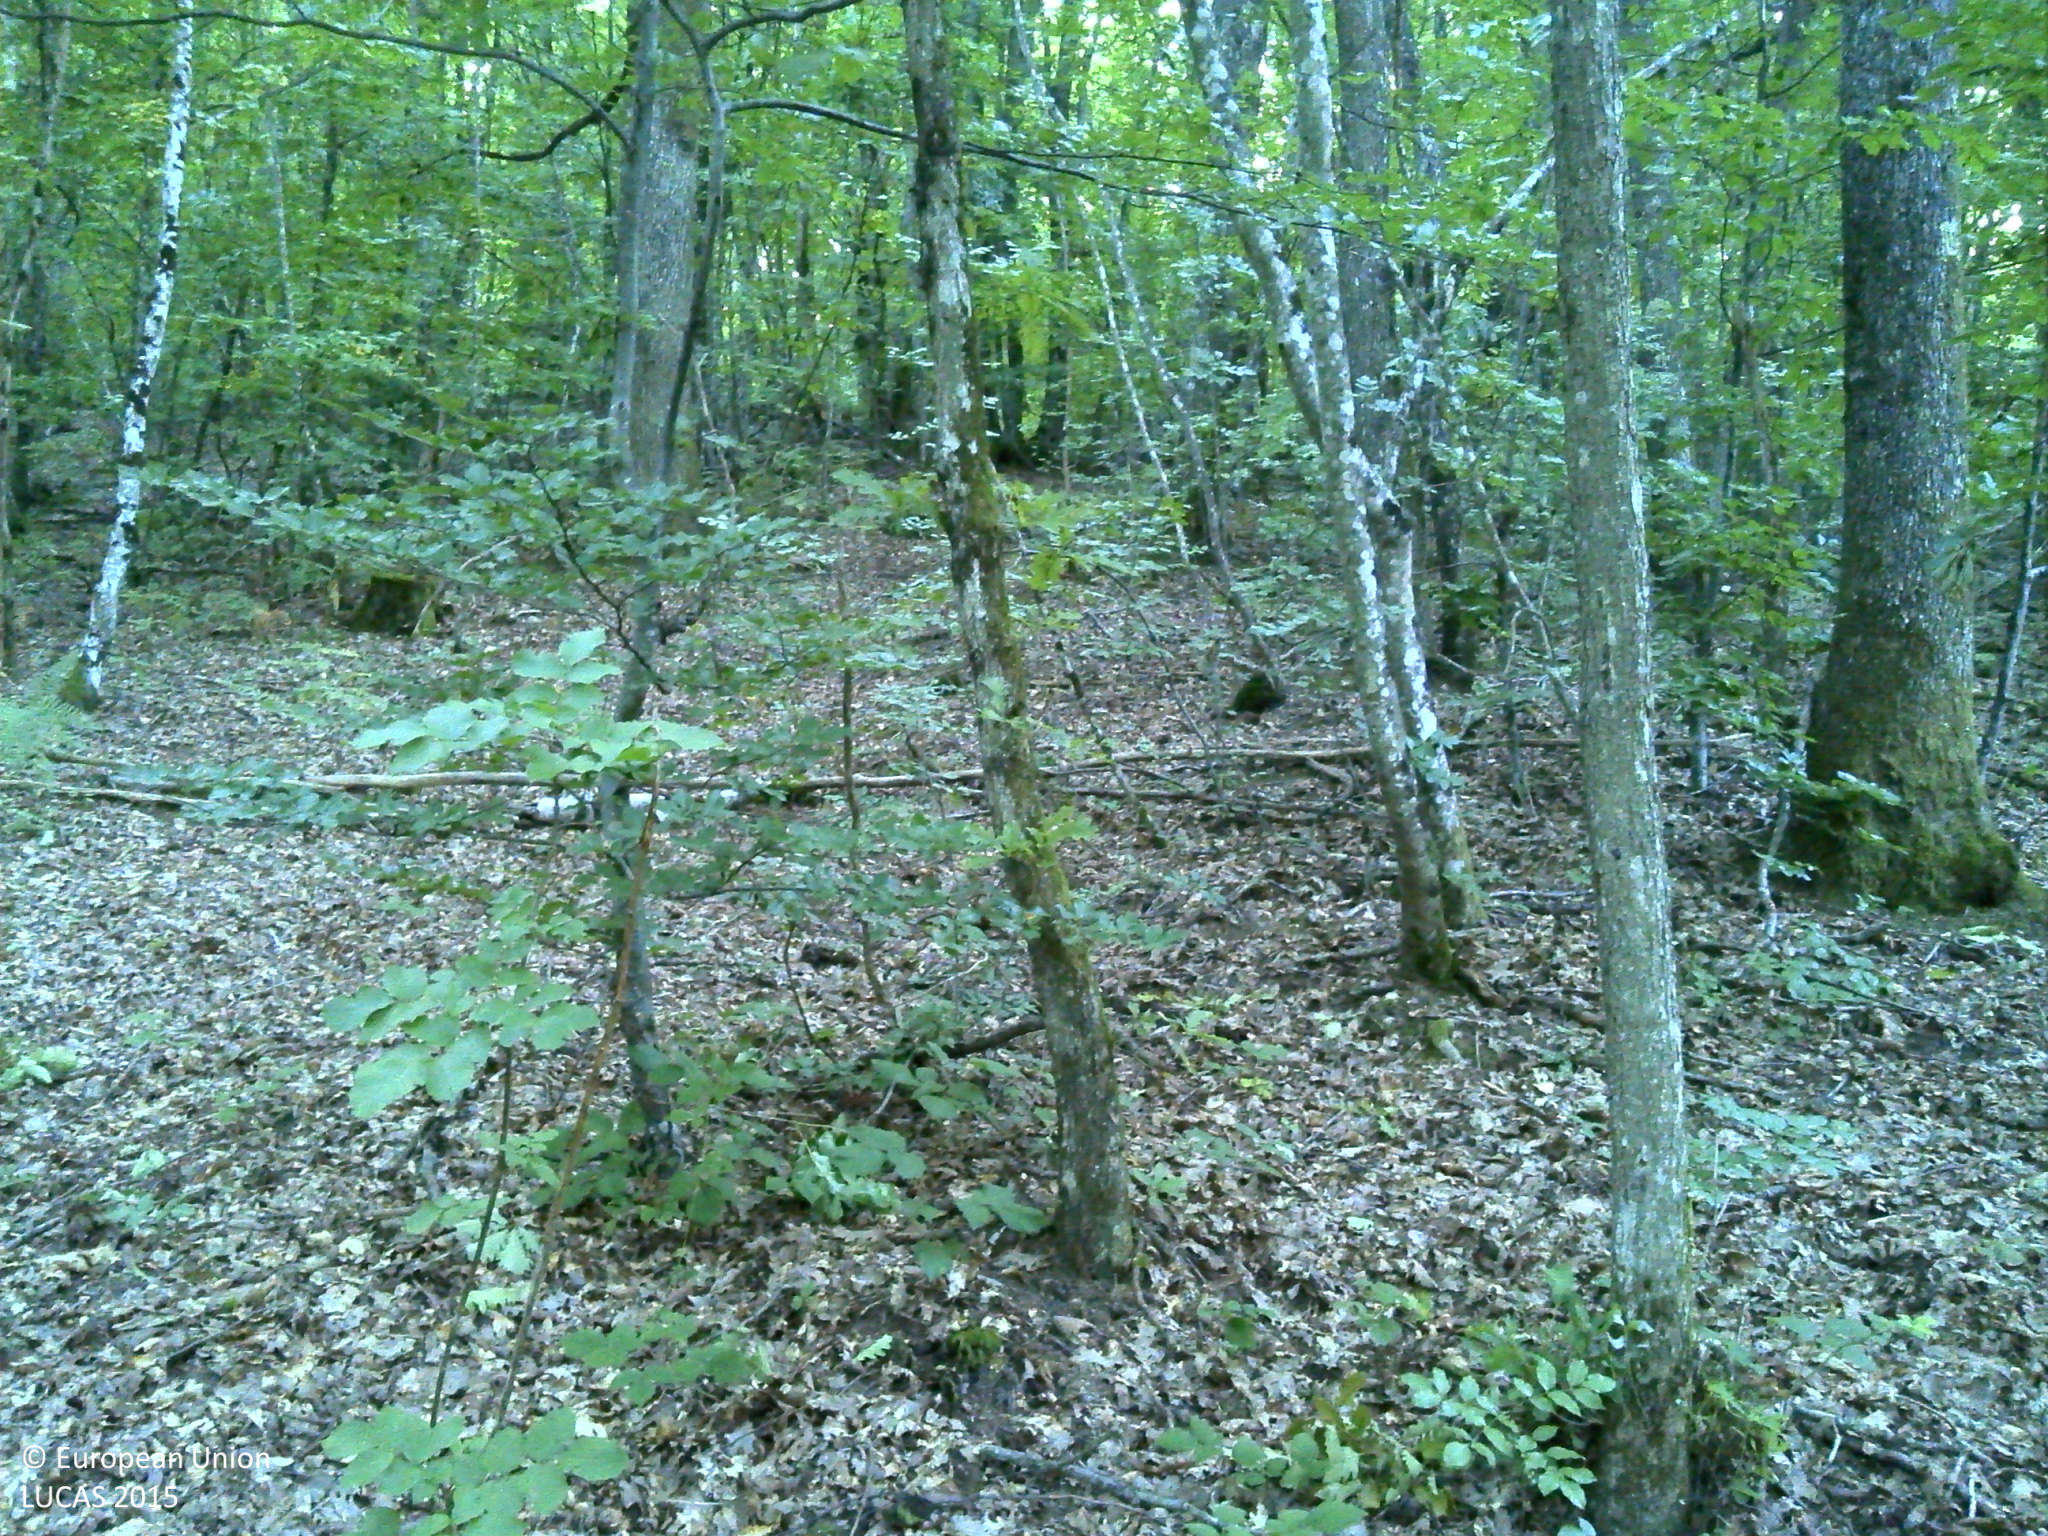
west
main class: Woodland
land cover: Broadleaved woodland
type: acidophilous oak and oak-birch forest
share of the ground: > 75 %
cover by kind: broadleaved forest trees 100 %
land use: Forestry
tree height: > 5 m
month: August
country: HR
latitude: 45.1555
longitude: 16.2676
